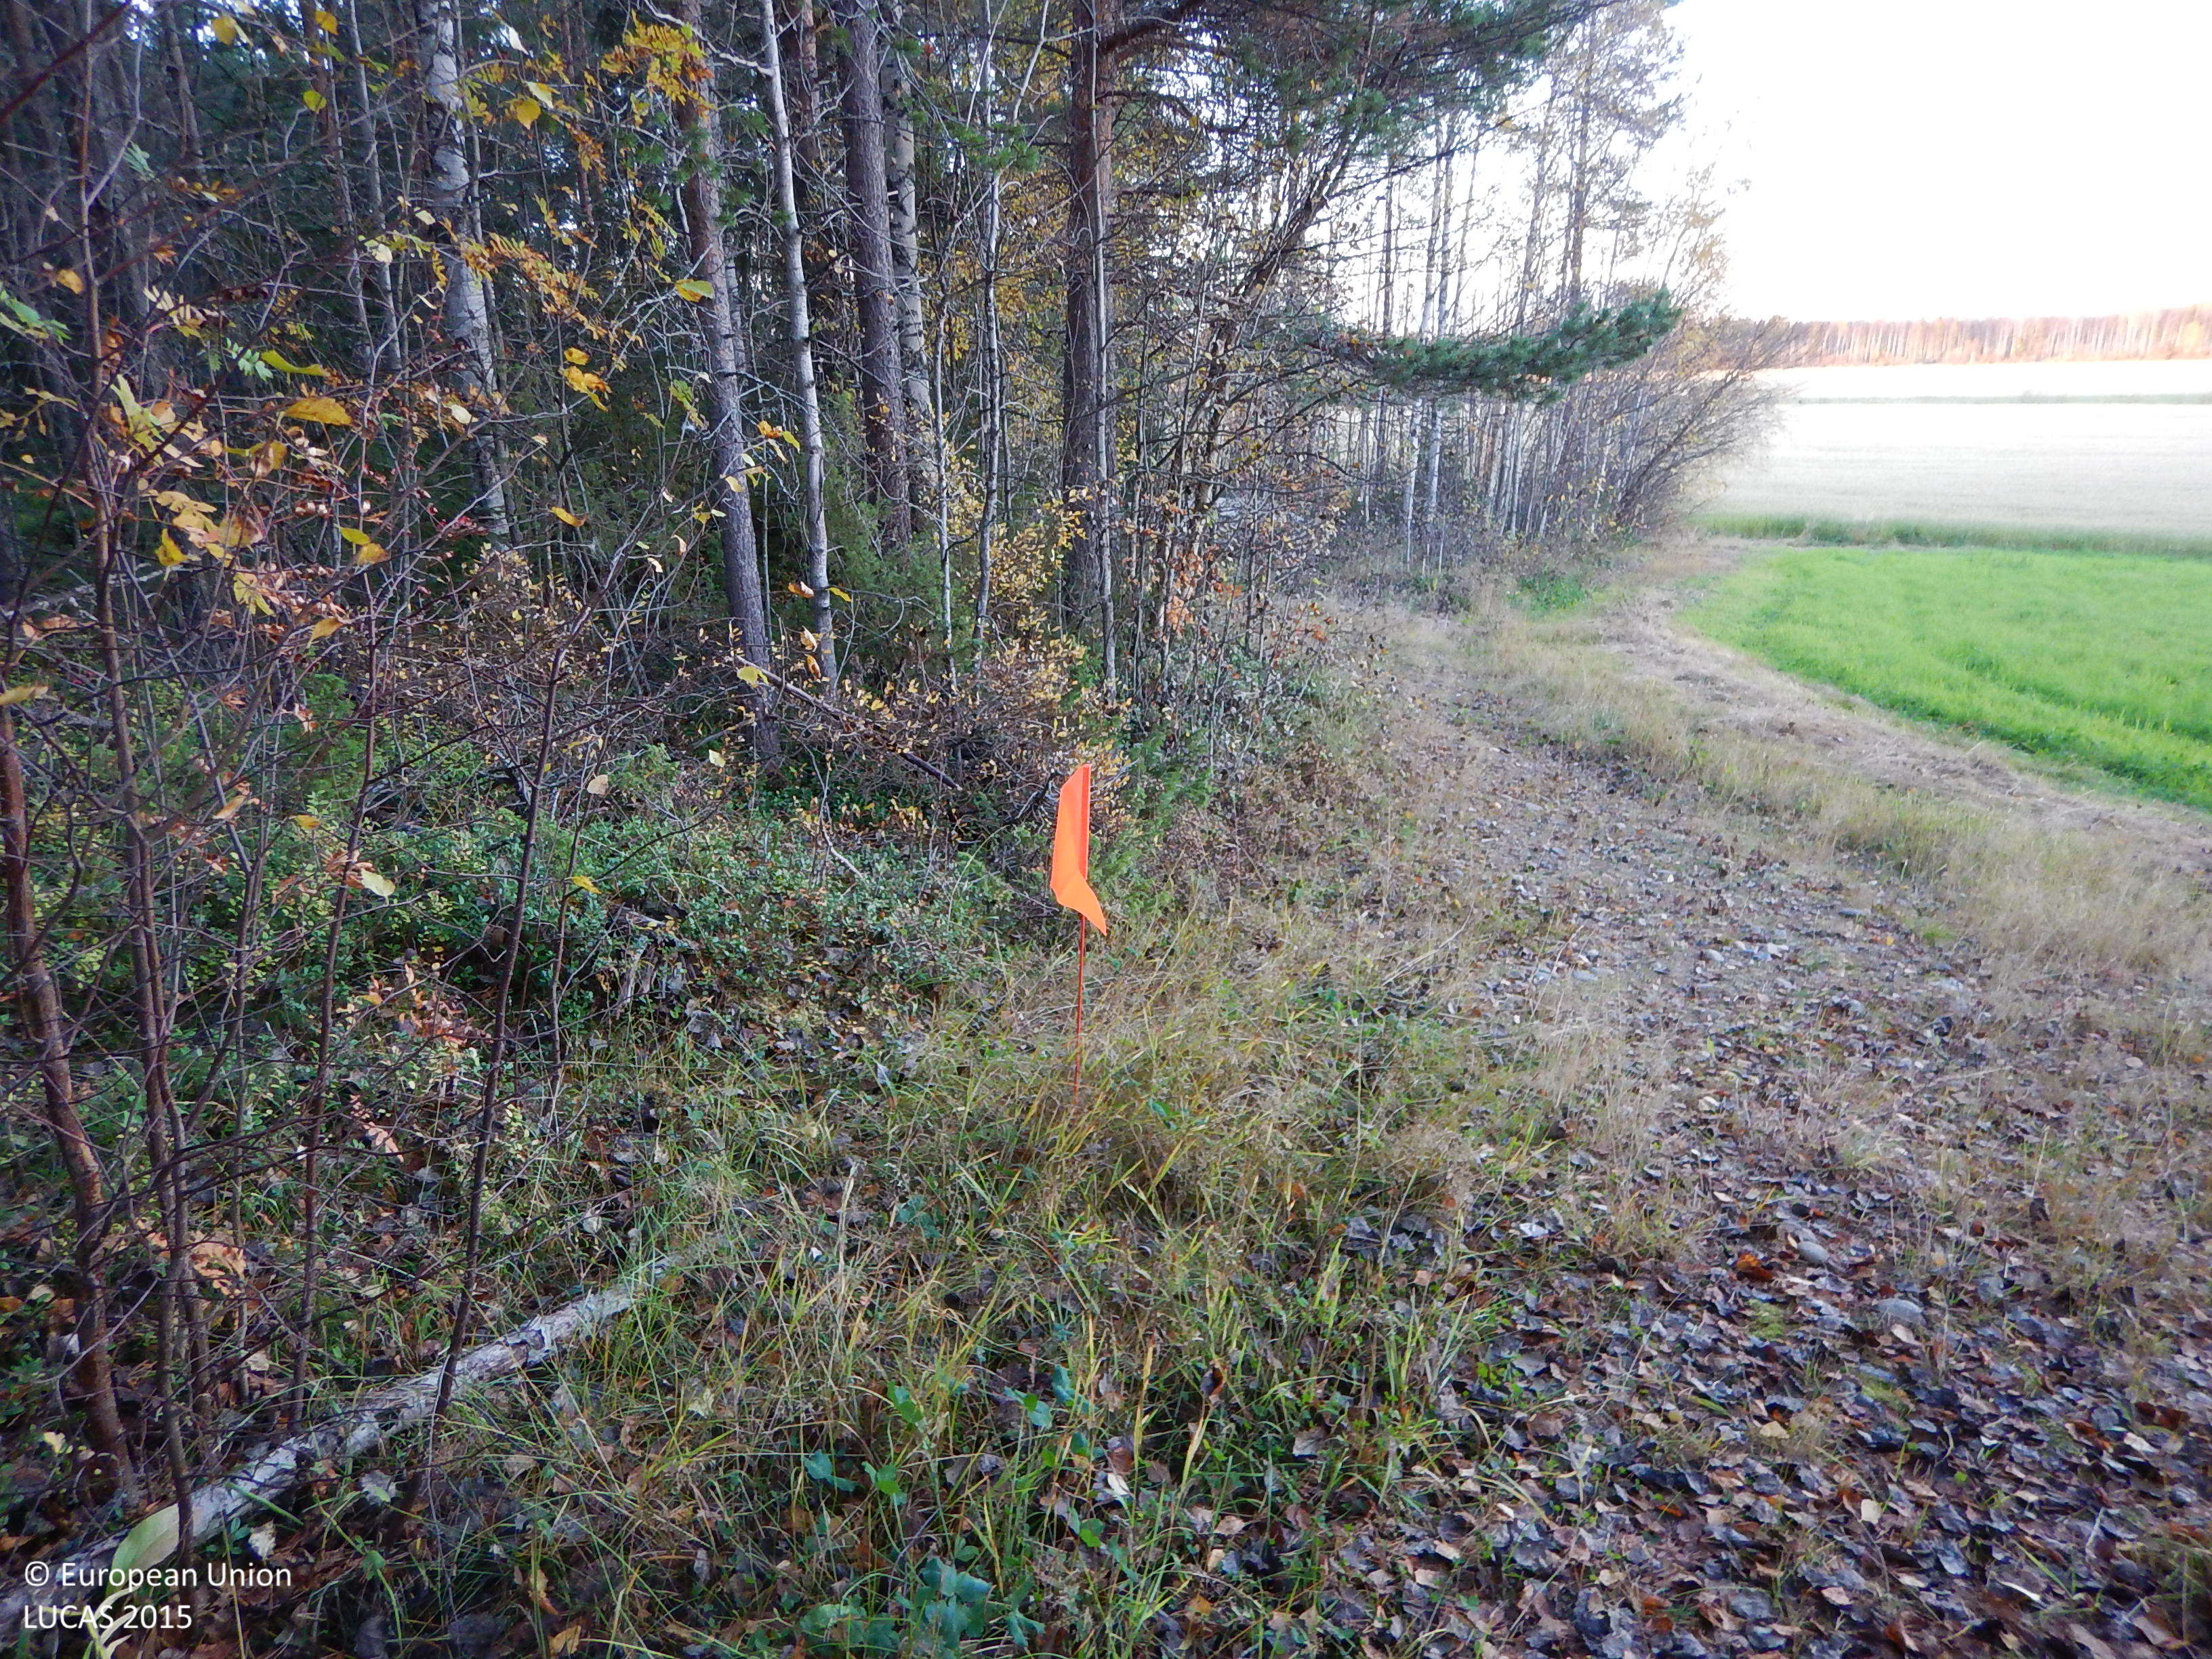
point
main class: Woodland
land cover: Pine dominated mixed woodland
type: boreal forest
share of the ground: 50 - 75 %
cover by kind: coniferous forest trees 40 %, broadleaved forest trees 20 %, shrubs 20 %, herbaceous plants 10 %, lichens and mosses 10 %
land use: Forestry
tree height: > 5 m
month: October
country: SE
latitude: 64.8876
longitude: 21.0643
